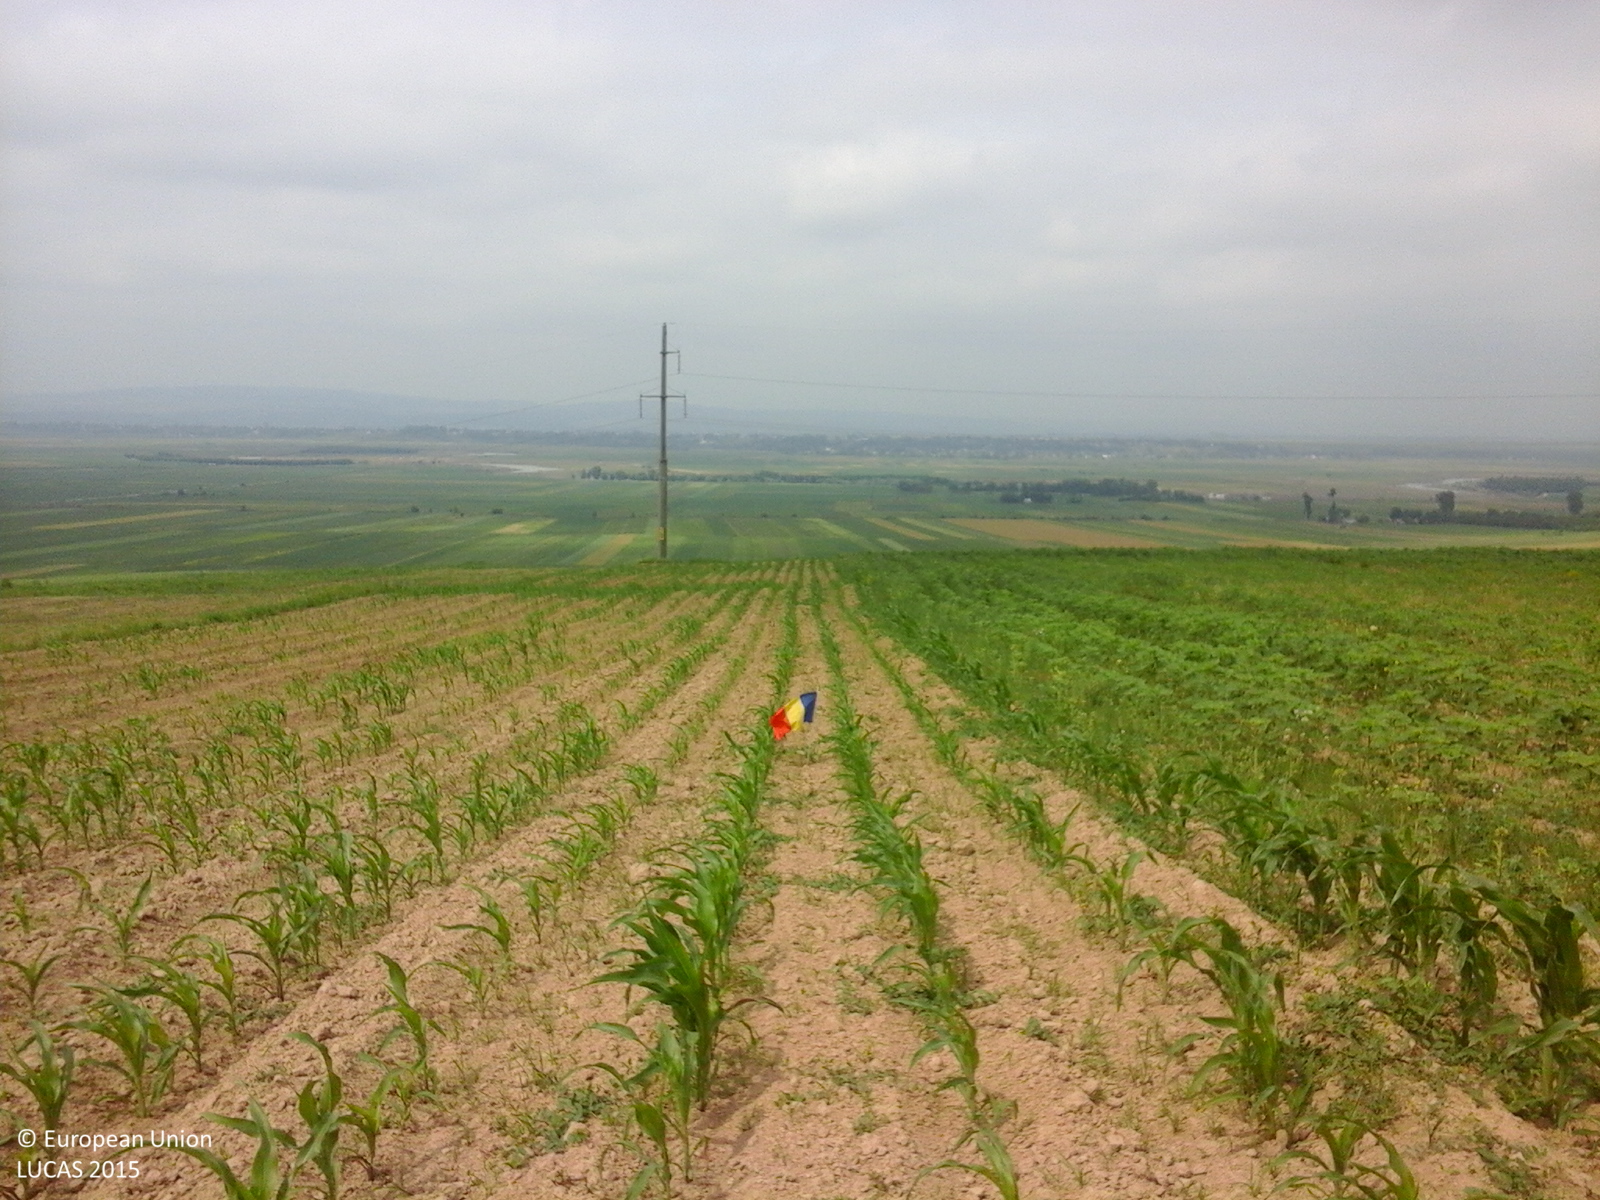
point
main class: Cropland
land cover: Maize
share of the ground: 10 - 25 %
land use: Agriculture (excluding fallow land and kitchen gardens)
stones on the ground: < 10 %
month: June
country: RO
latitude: 47.6181
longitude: 26.5767
